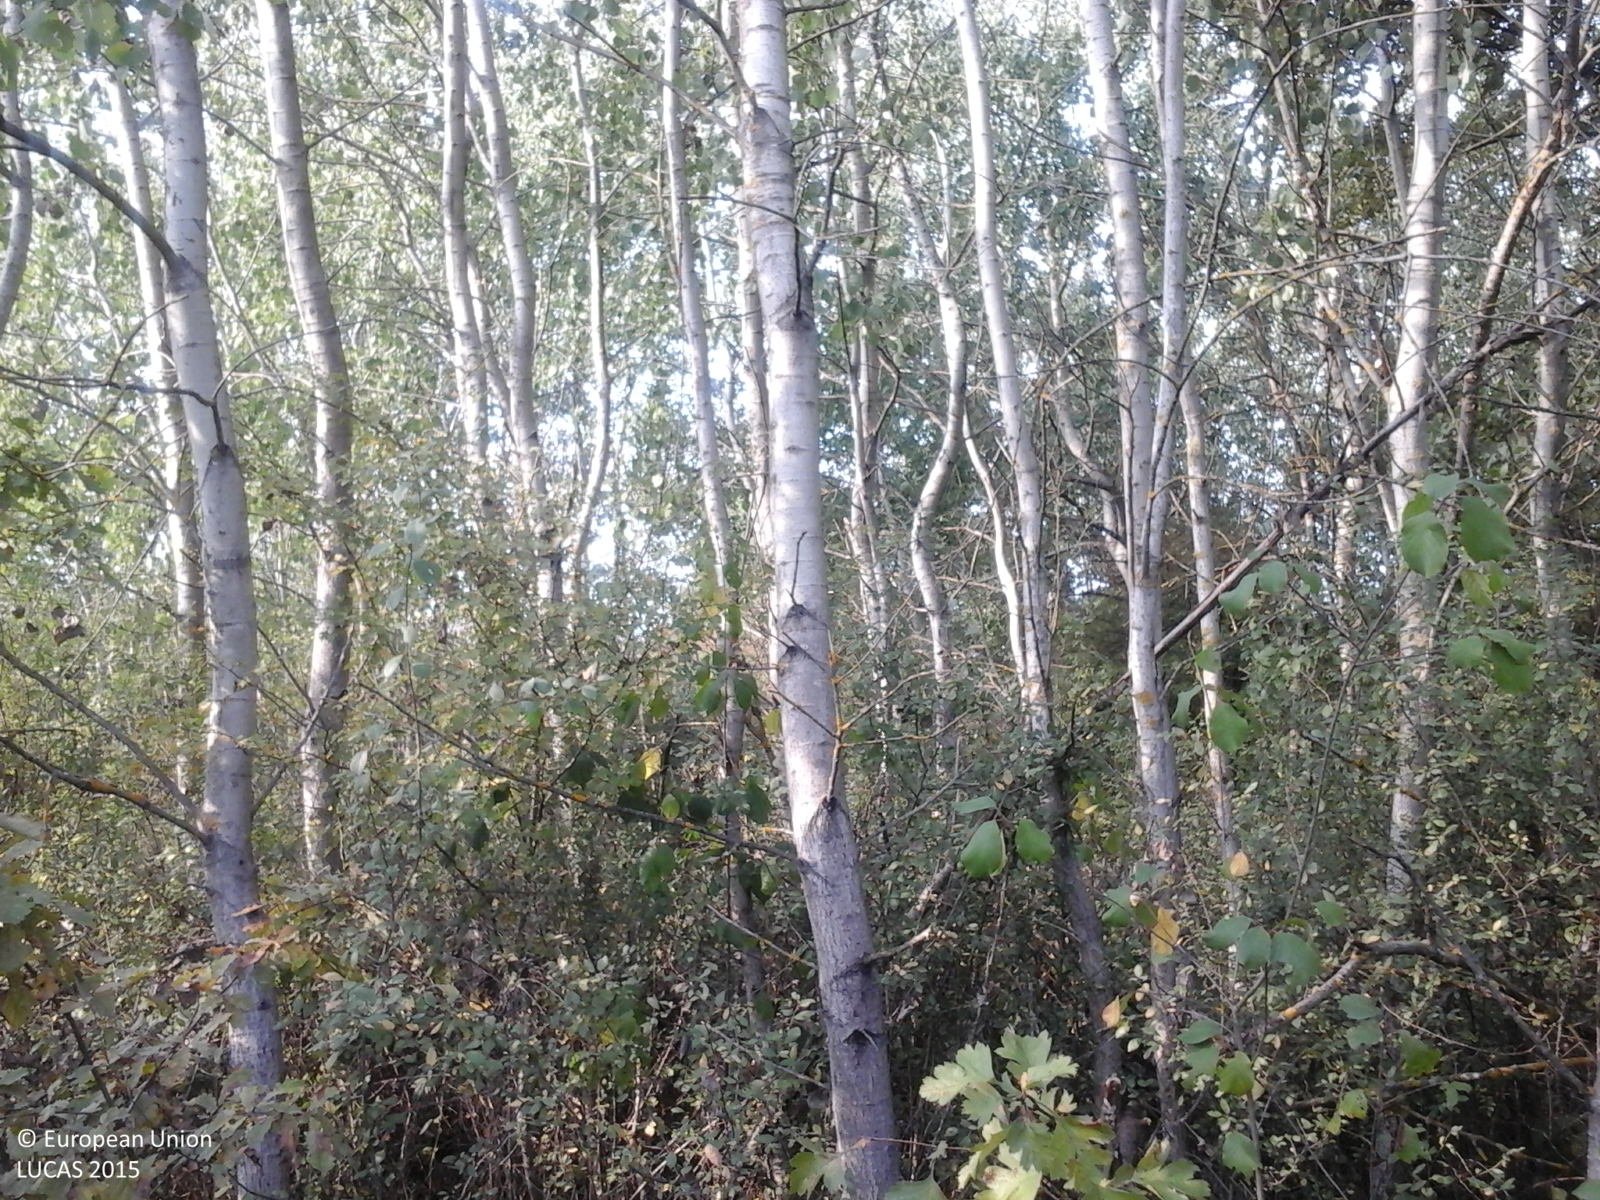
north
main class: Woodland
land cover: Broadleaved woodland
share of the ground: > 75 %
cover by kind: broadleaved forest trees 100 %
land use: Forestry
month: September
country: RO
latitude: 45.5087
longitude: 22.3177
